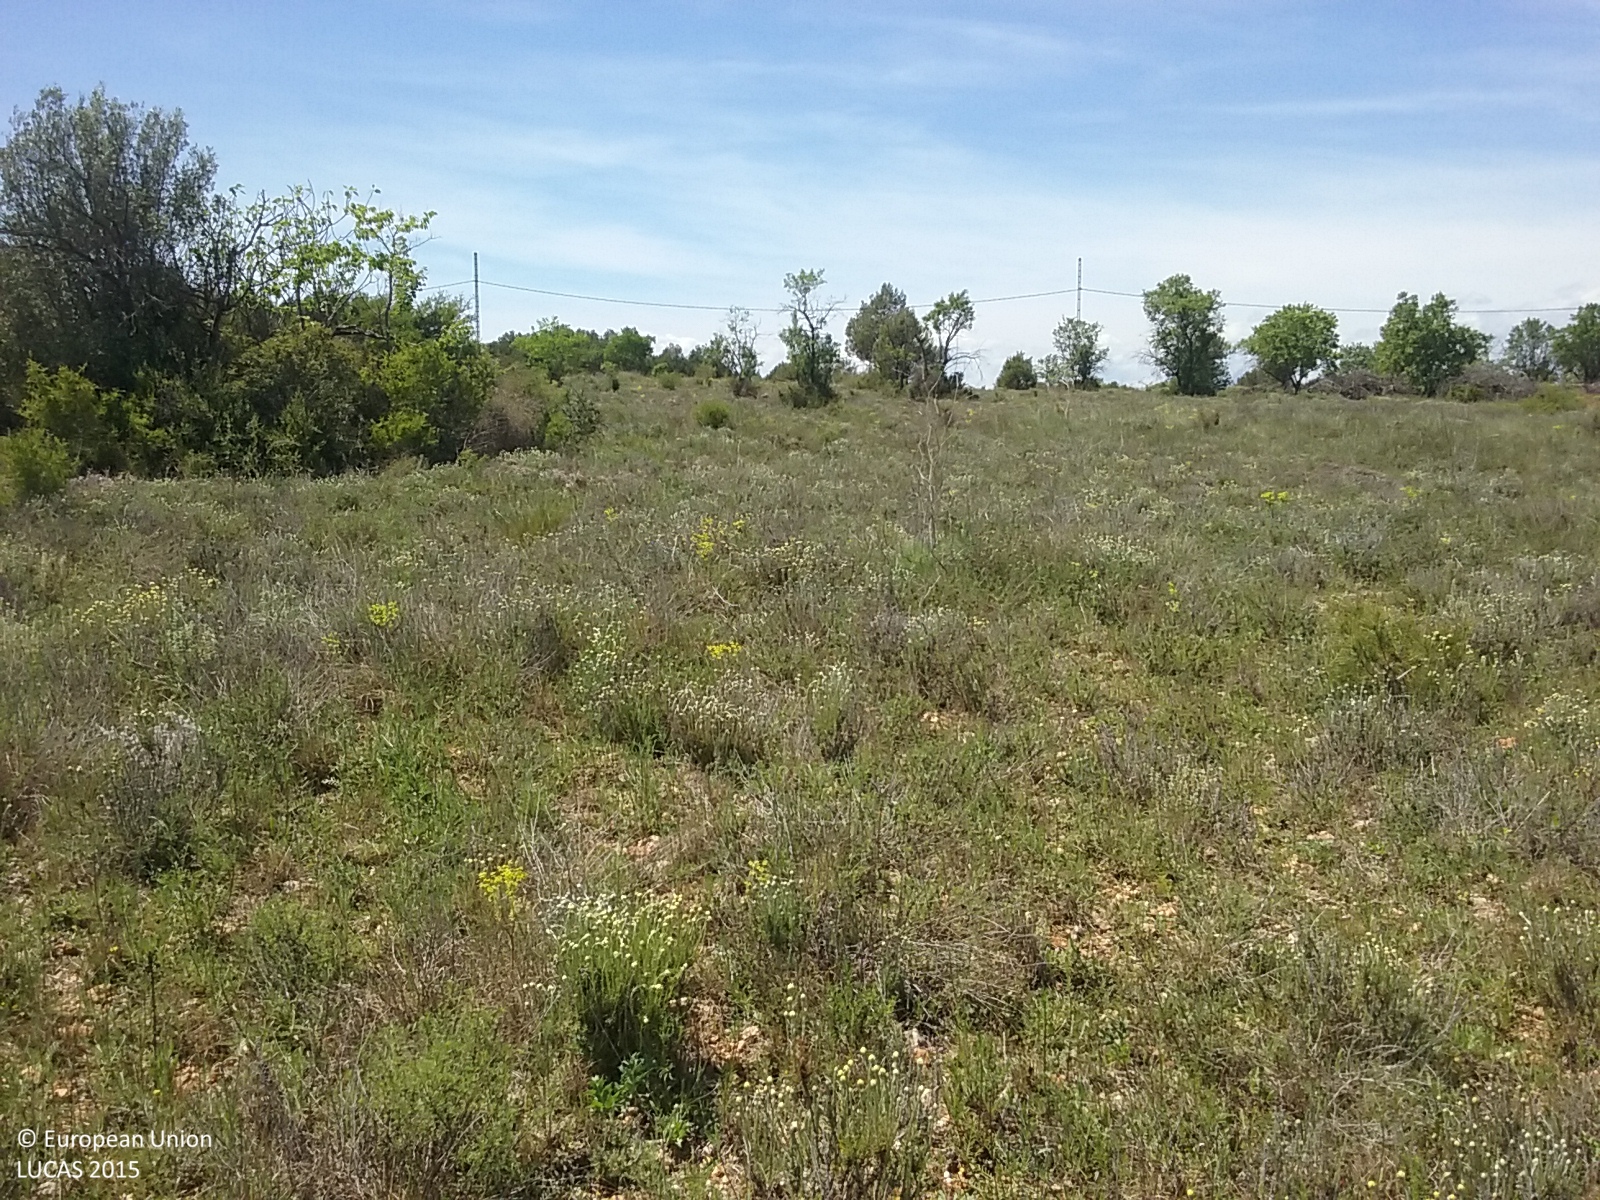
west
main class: Grassland
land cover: Spontaneously vegetated surfaces
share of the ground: > 75 %
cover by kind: herbaceous plants 95 %, shrubs 5 %
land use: Abandoned areas
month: May
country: ES
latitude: 40.1363
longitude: -0.0137
